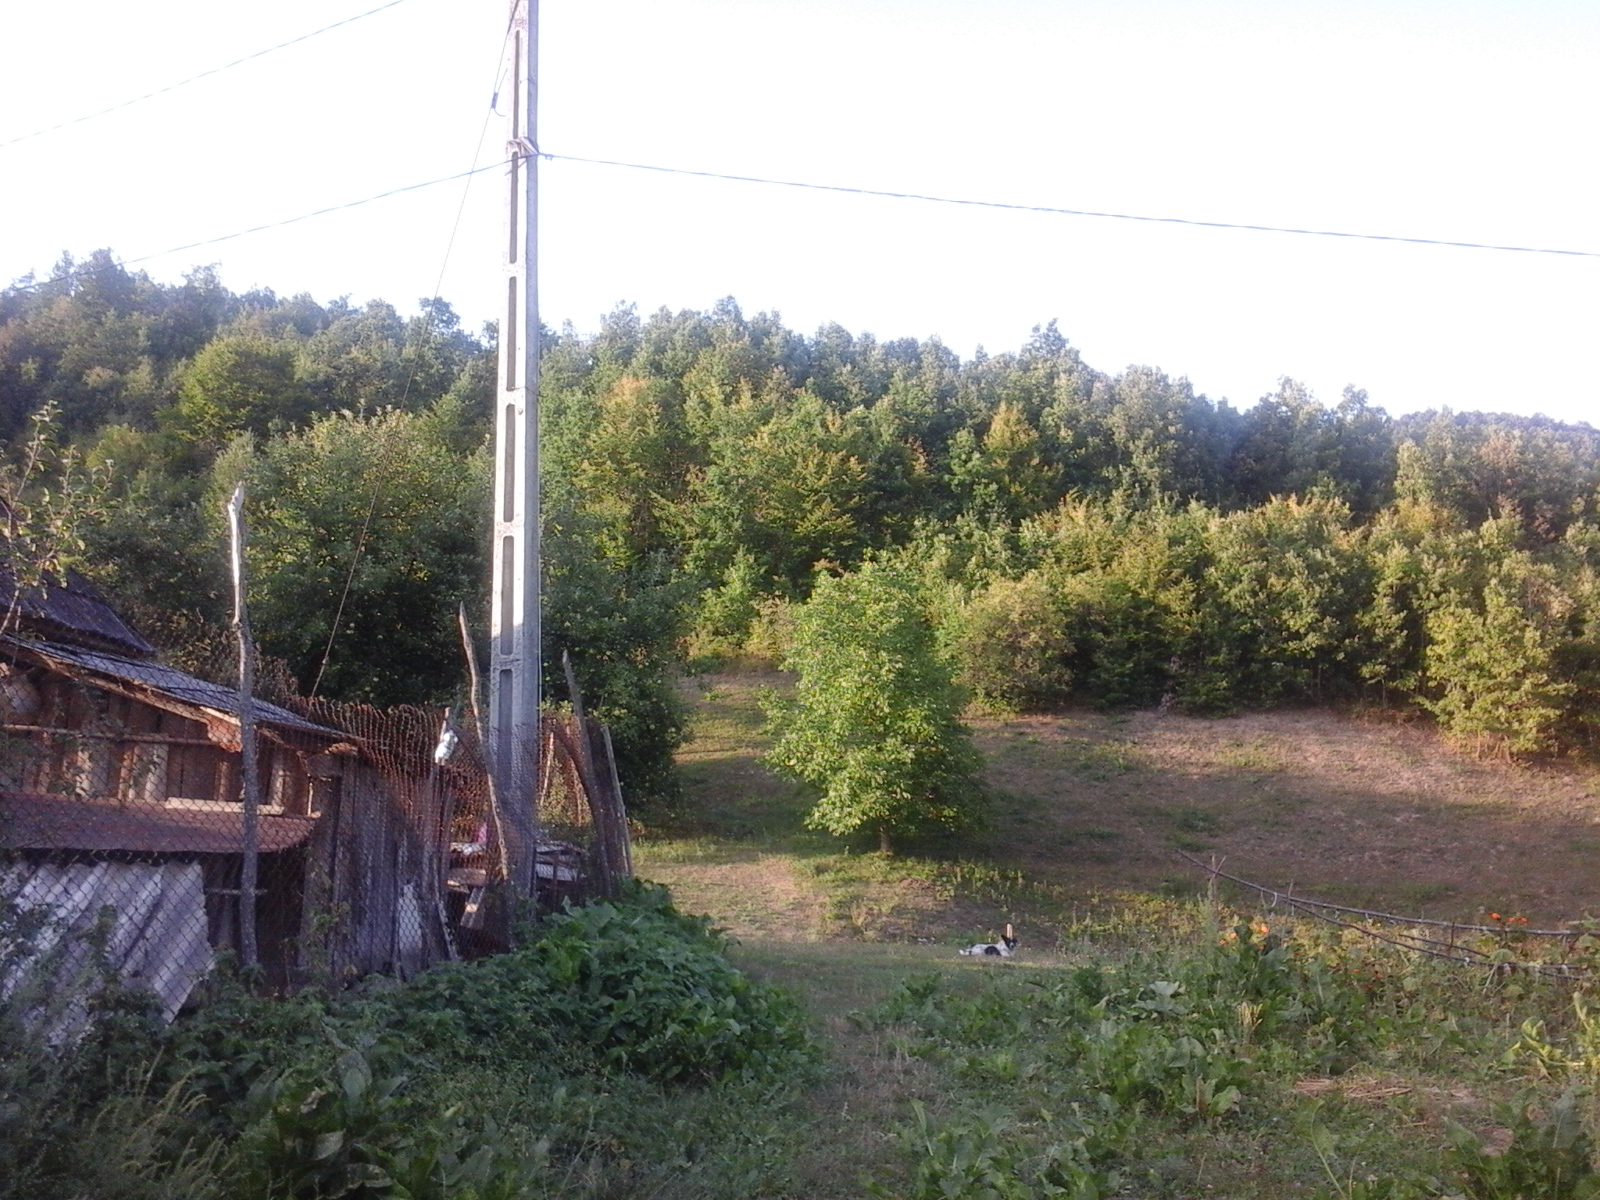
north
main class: Grassland
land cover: Spontaneously vegetated surfaces
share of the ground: > 75 %
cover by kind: herbaceous plants 100 %
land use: Agriculture (excluding fallow land and kitchen gardens)
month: September
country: RO
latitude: 47.7248
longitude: 24.1530
